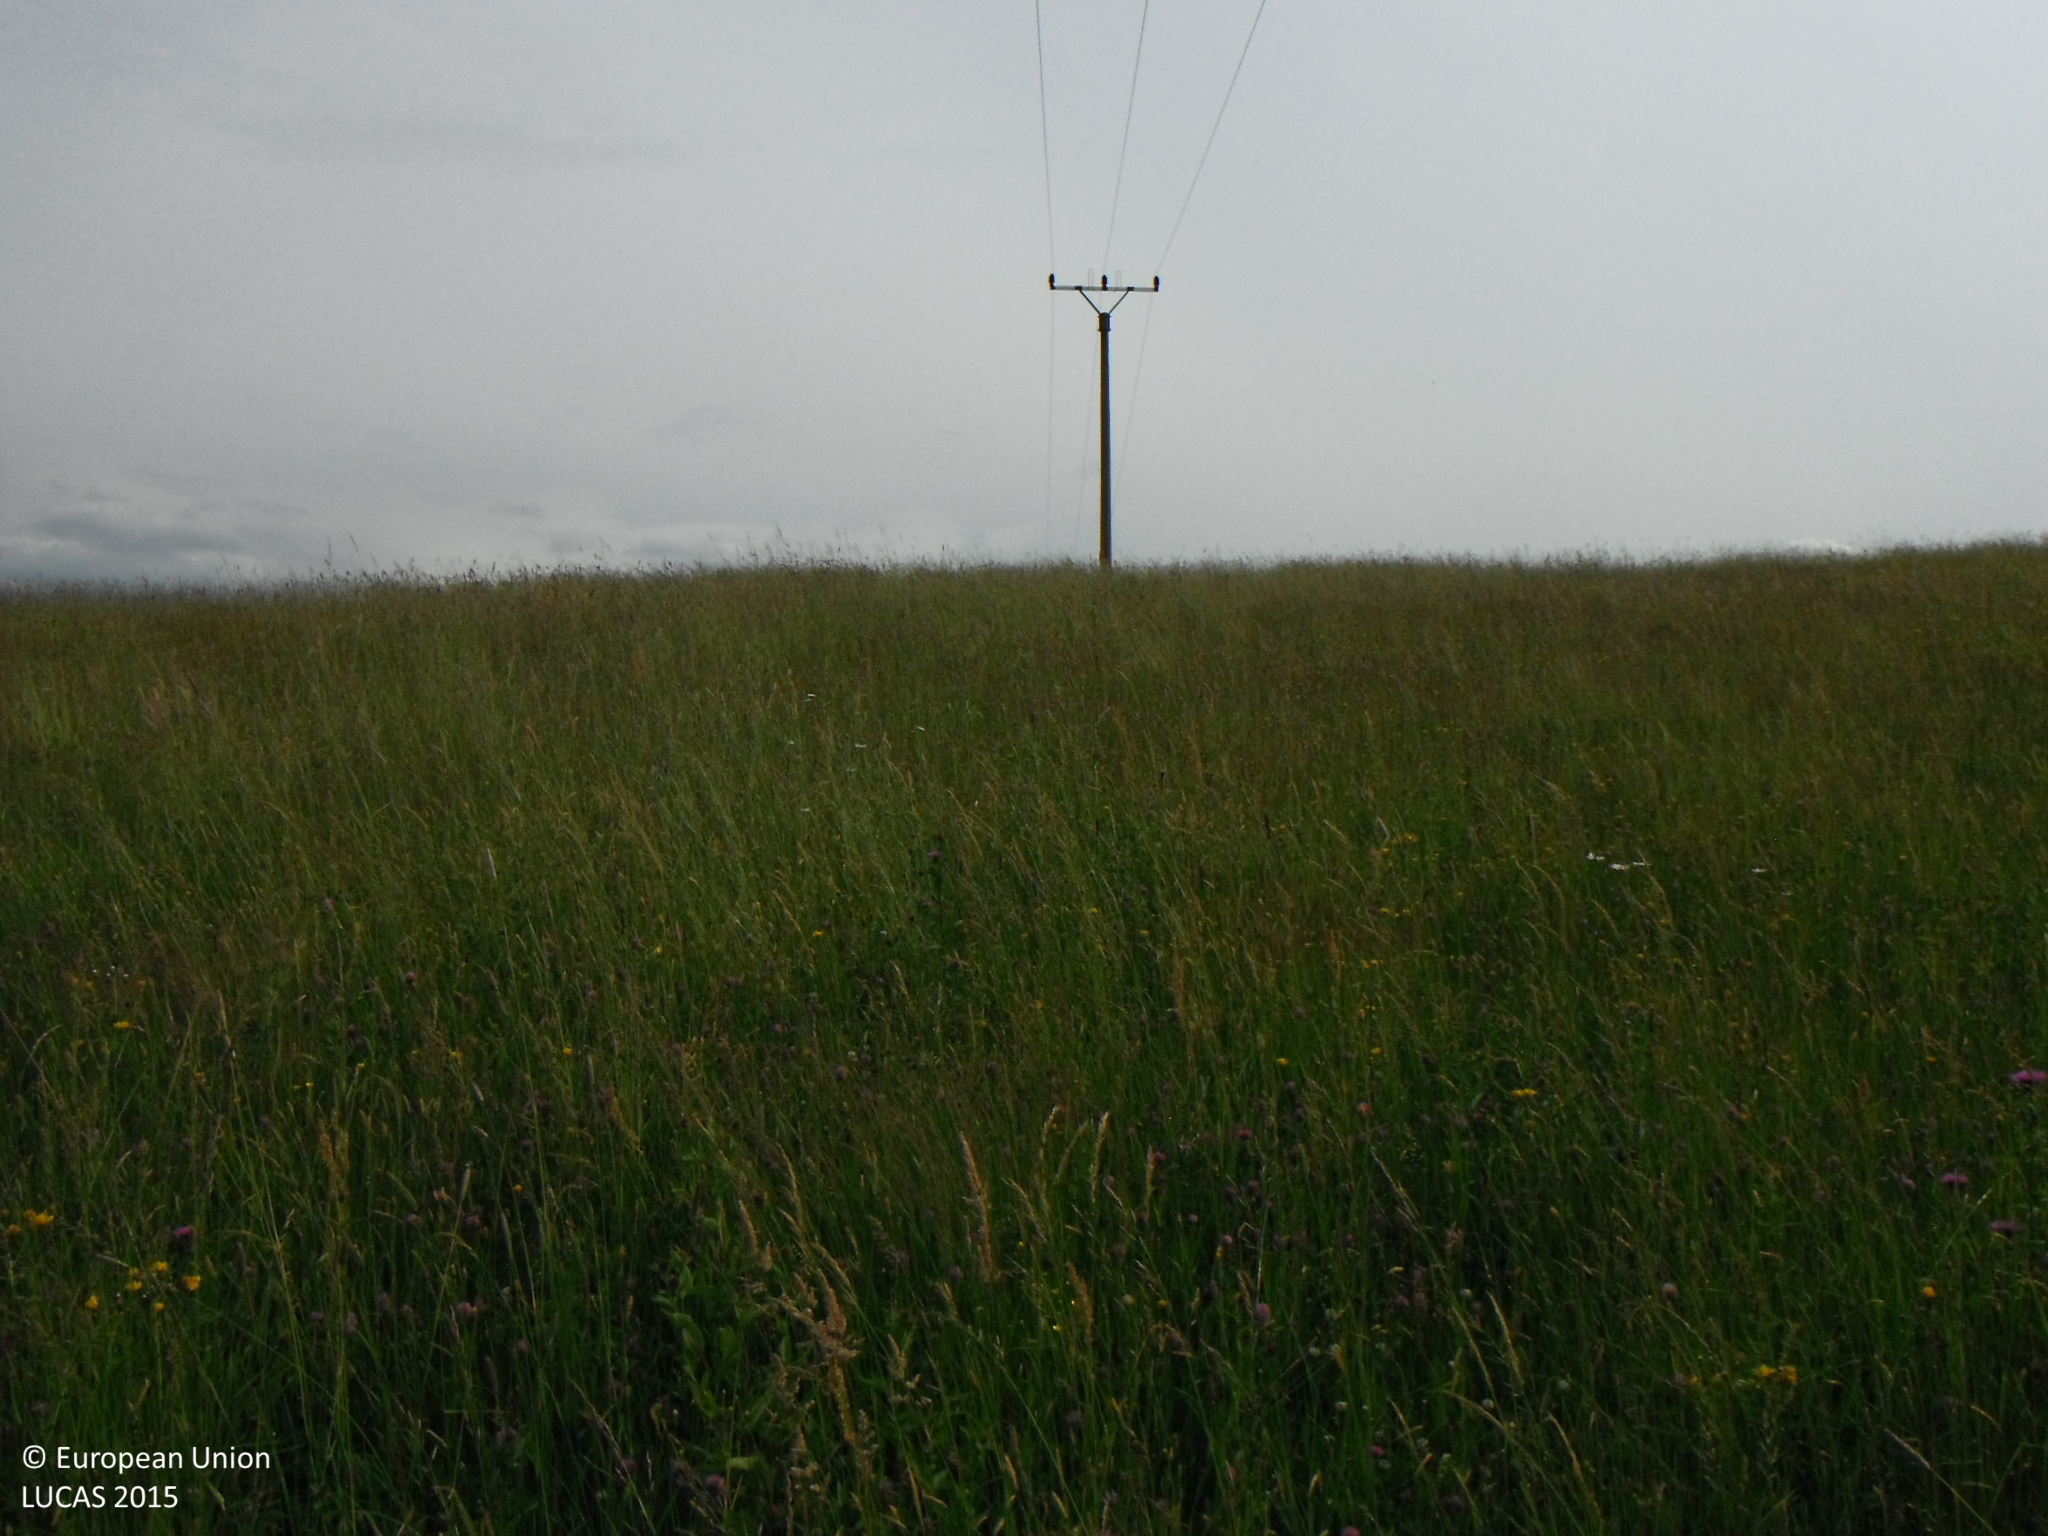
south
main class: Grassland
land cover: Grassland without tree/shrub cover
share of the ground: > 75 %
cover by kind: herbaceous plants 100 %
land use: Agriculture (excluding fallow land and kitchen gardens)
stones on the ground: < 10 %
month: June
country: SK
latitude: 49.0661
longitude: 19.4560
